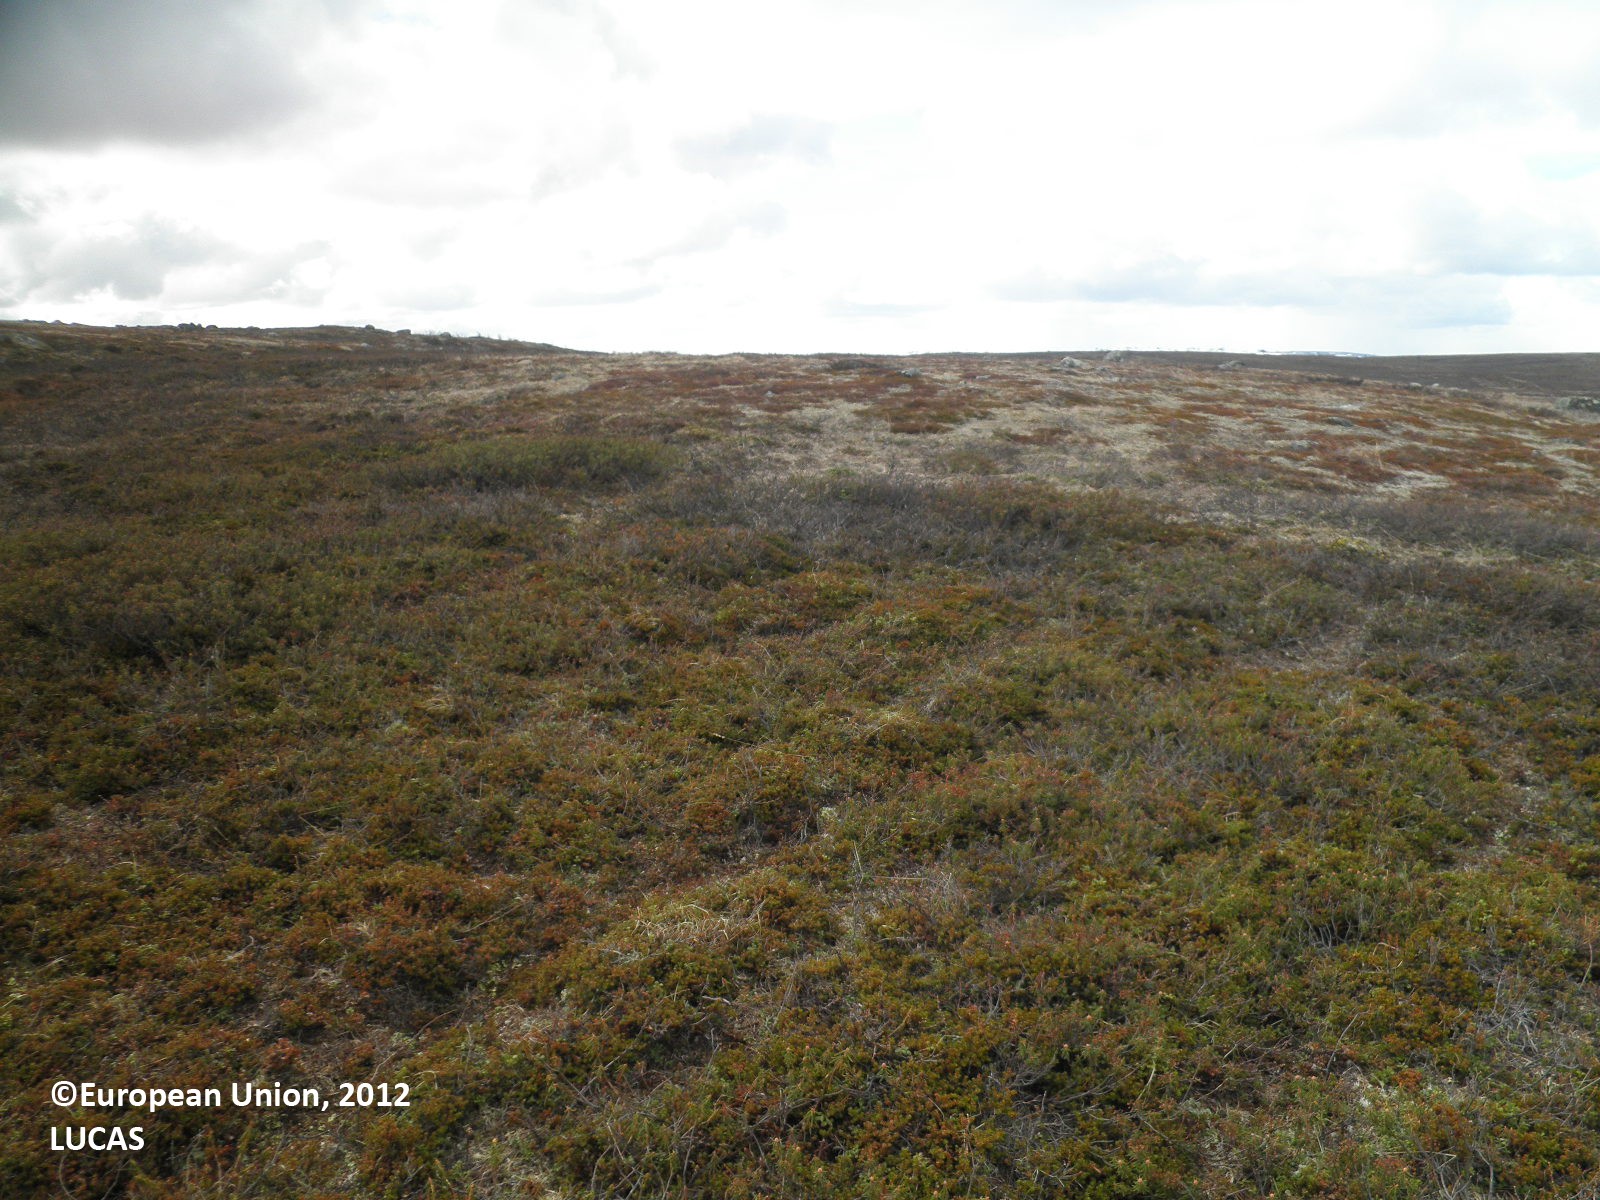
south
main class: Shrubland
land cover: Shrubland without tree cover
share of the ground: > 75 %
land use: Semi-natural and natural areas not in use
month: May
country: FI
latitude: 70.0667
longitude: 27.9062
